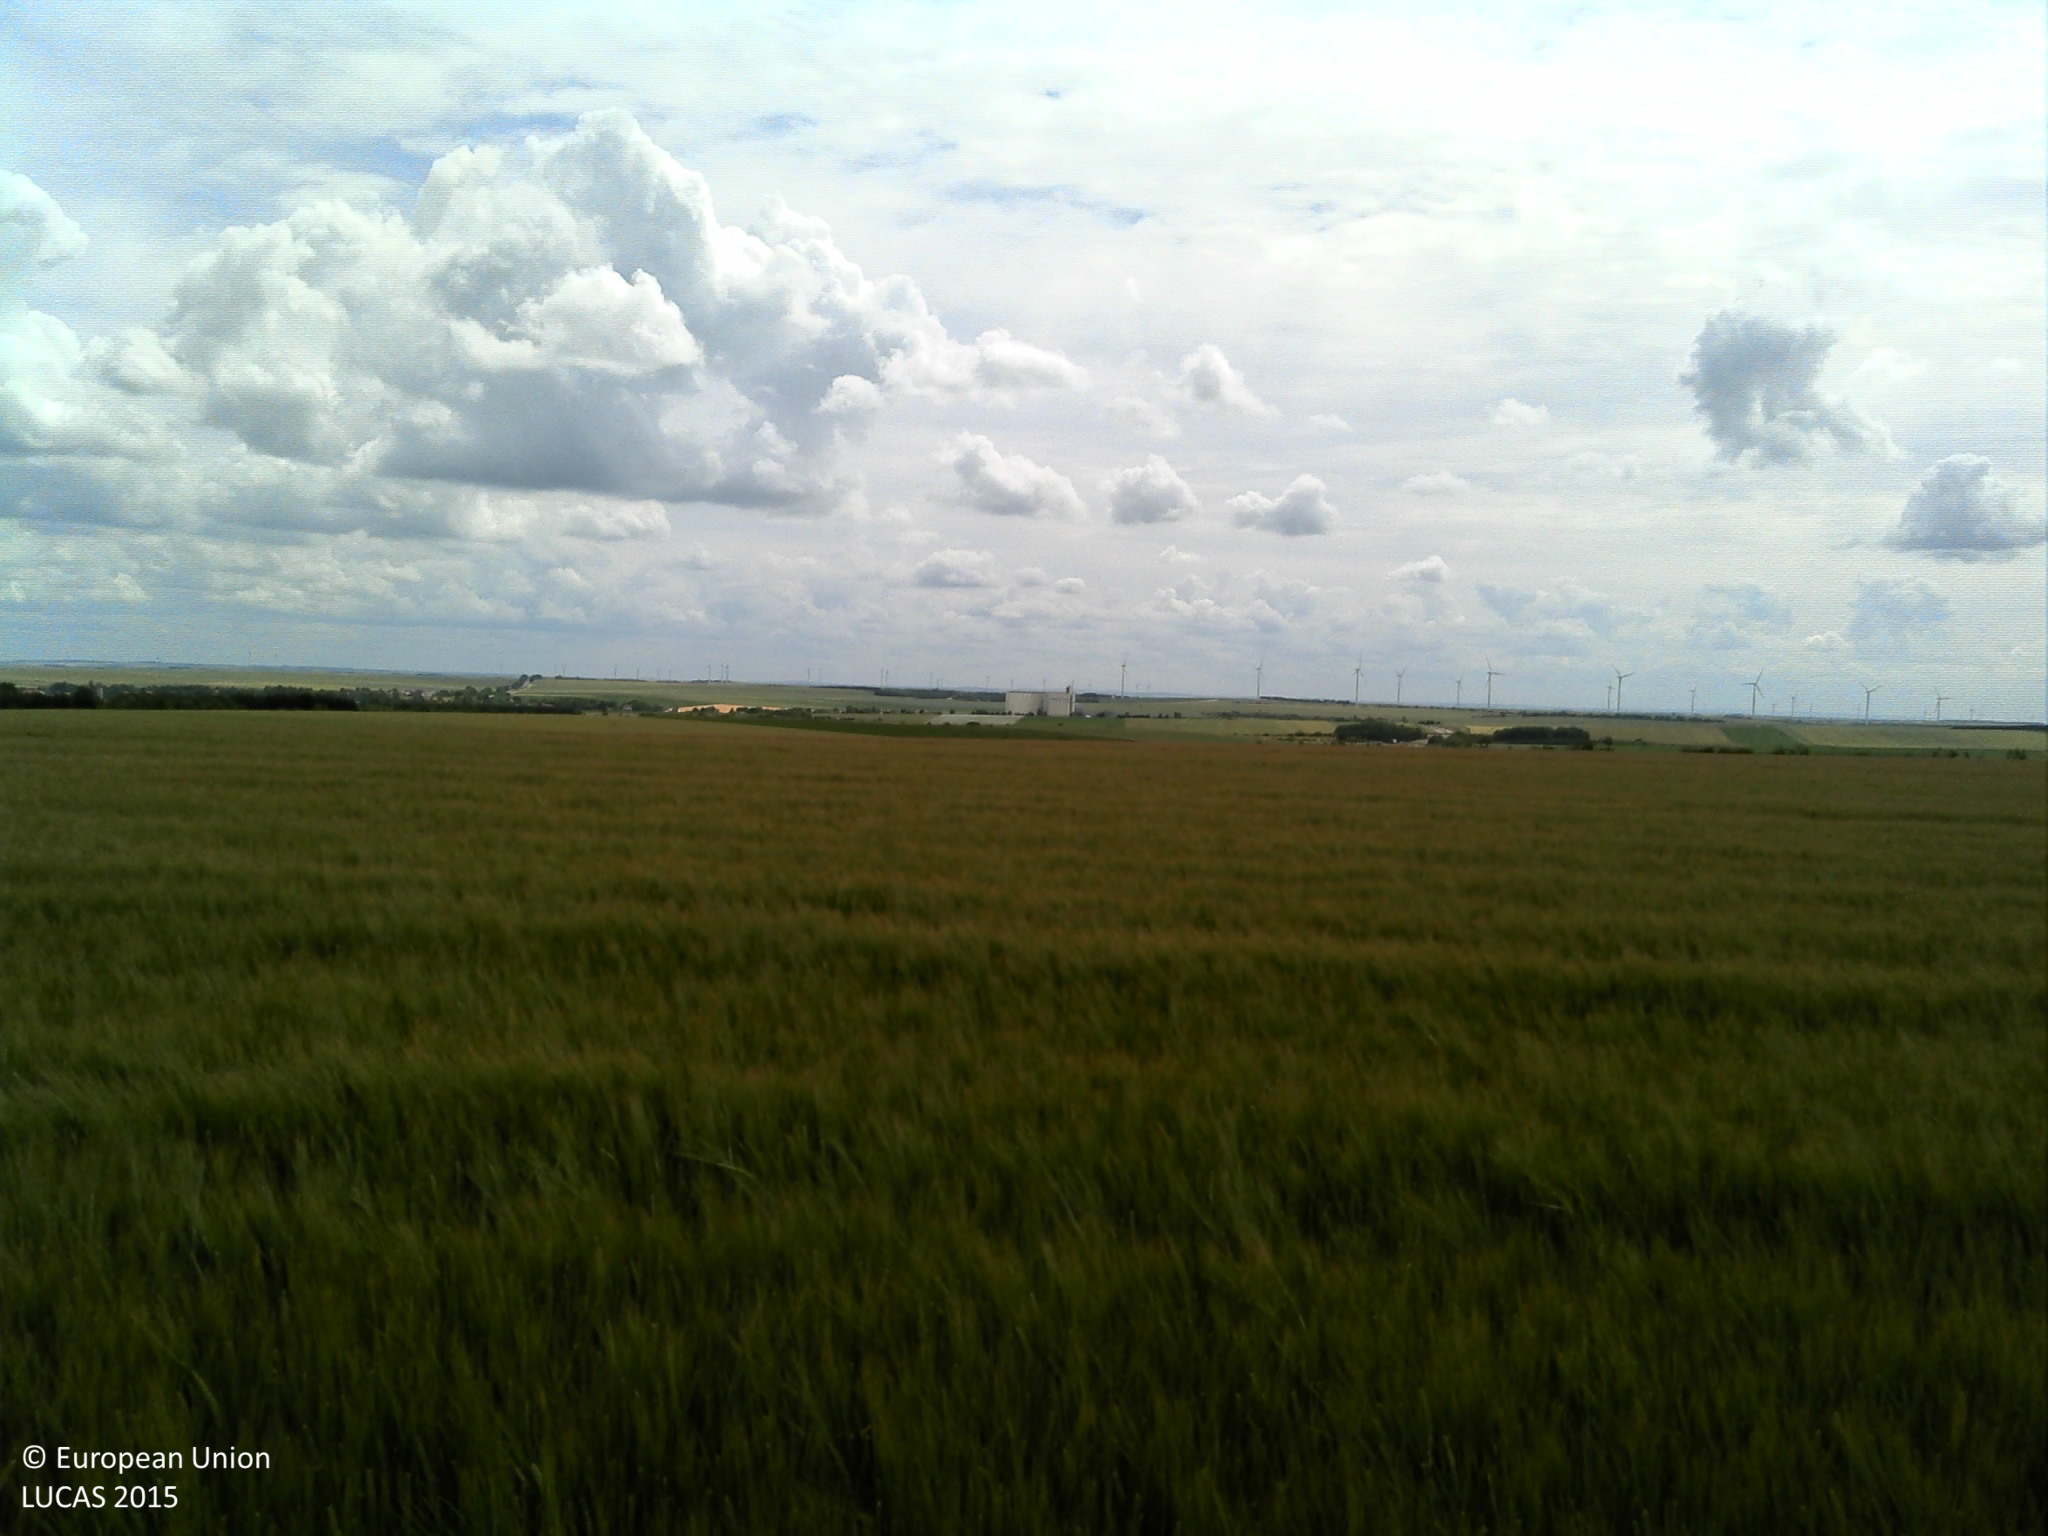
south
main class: Cropland
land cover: Barley
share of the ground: > 75 %
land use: Agriculture (excluding fallow land and kitchen gardens)
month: June
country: FR
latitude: 48.7019
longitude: 4.1941
